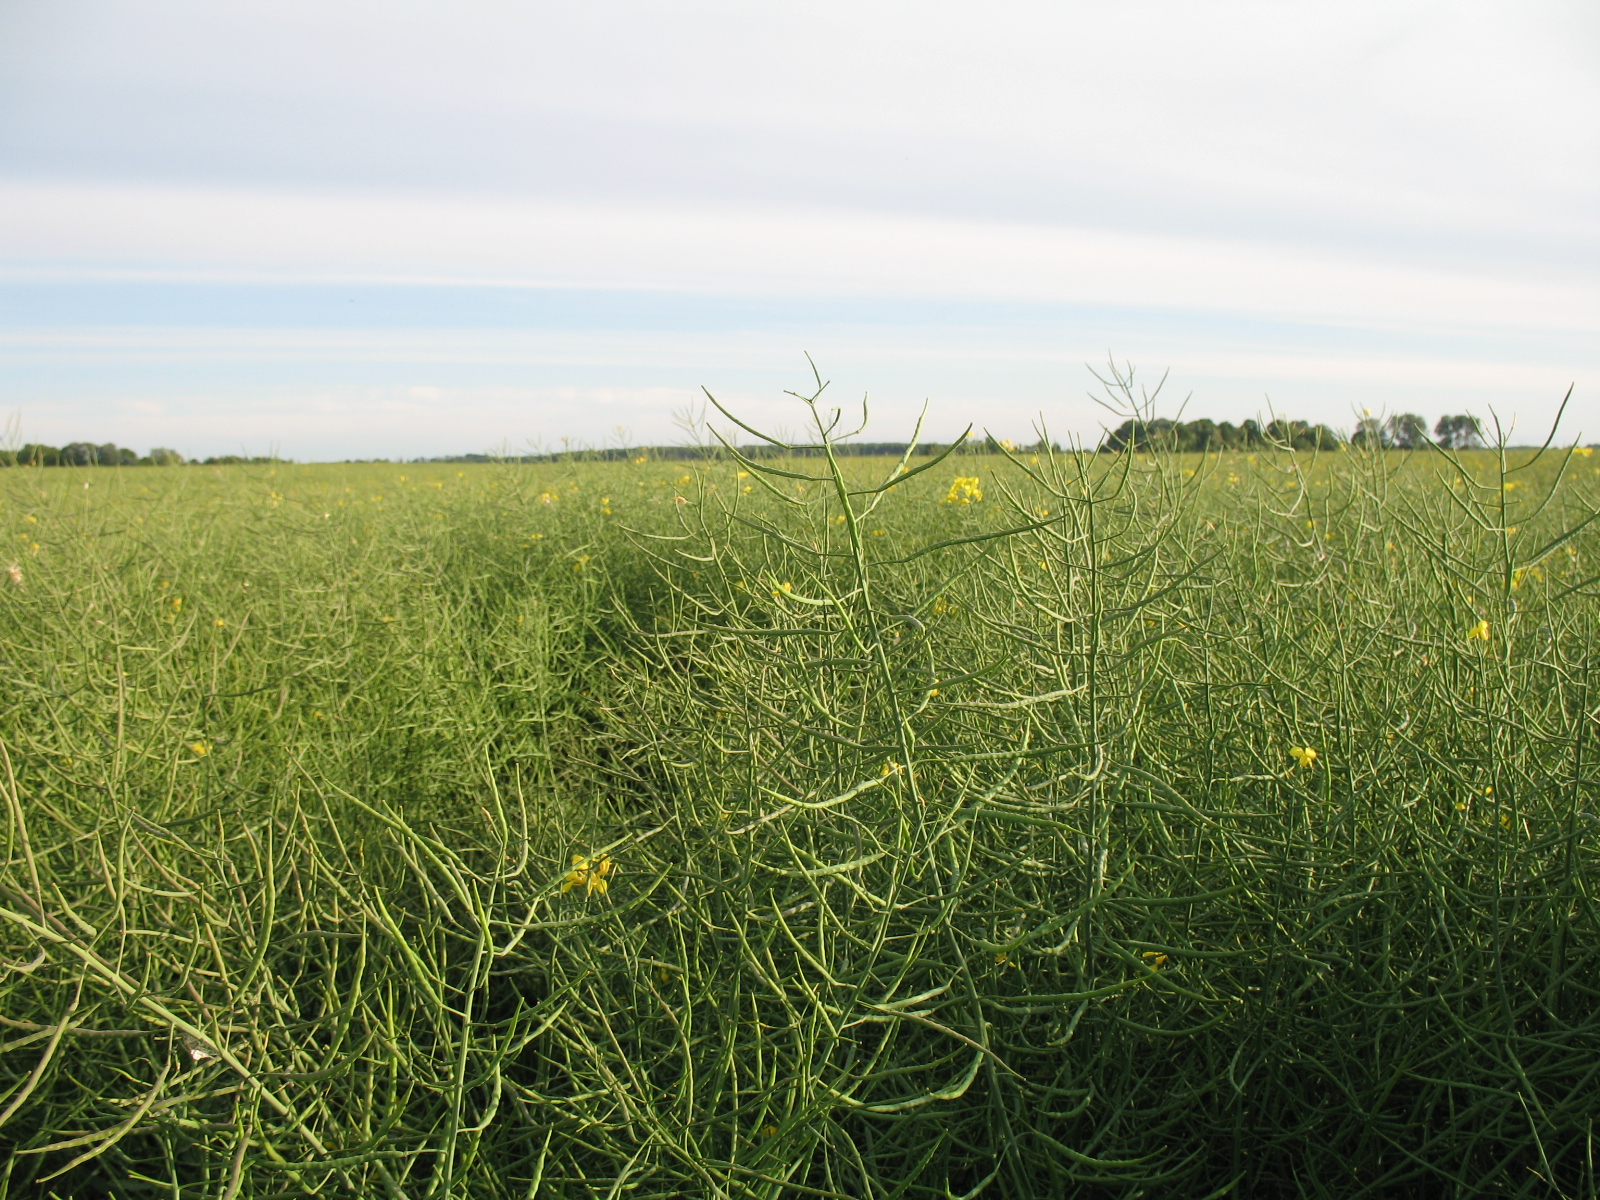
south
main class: Cropland
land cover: Rape and turnip rape
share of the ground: > 75 %
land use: Agriculture (excluding fallow land and kitchen gardens)
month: June
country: LV
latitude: 56.5866
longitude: 23.4747
